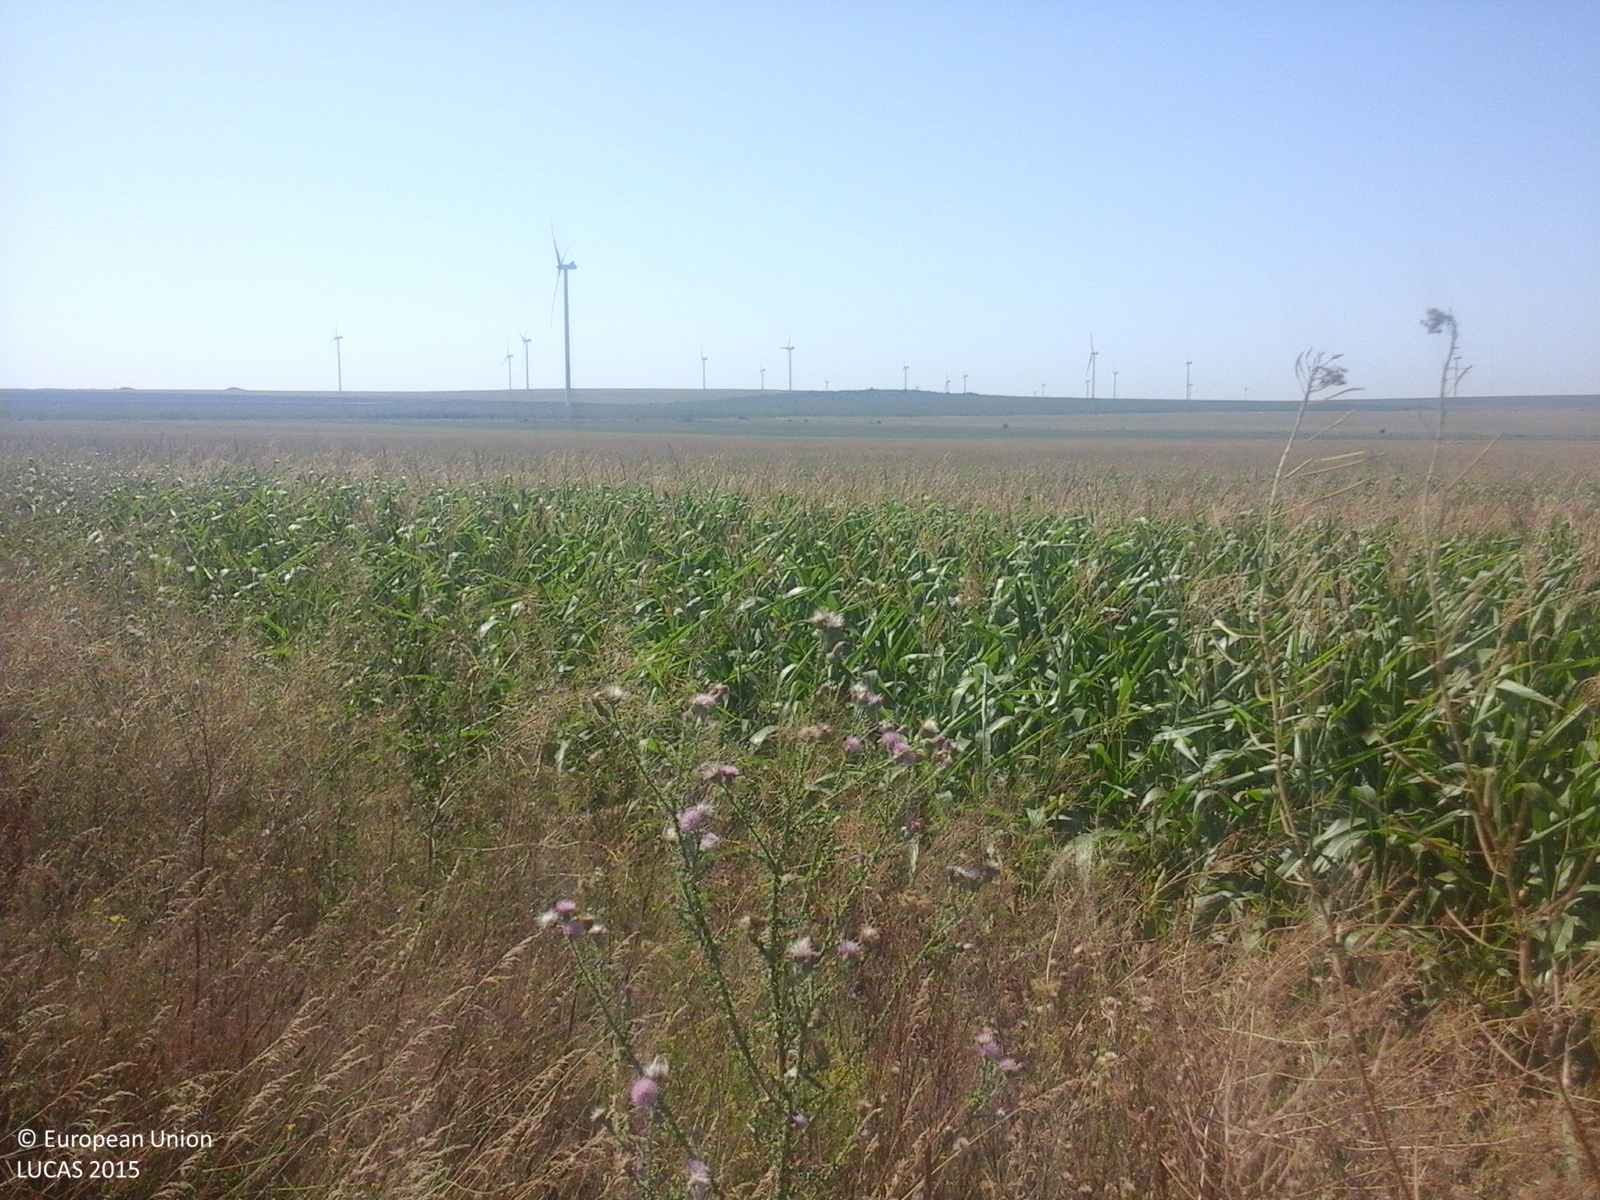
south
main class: Cropland
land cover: Maize
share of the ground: > 75 %
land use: Agriculture (excluding fallow land and kitchen gardens)
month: August
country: RO
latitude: 44.6203
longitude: 28.2263
